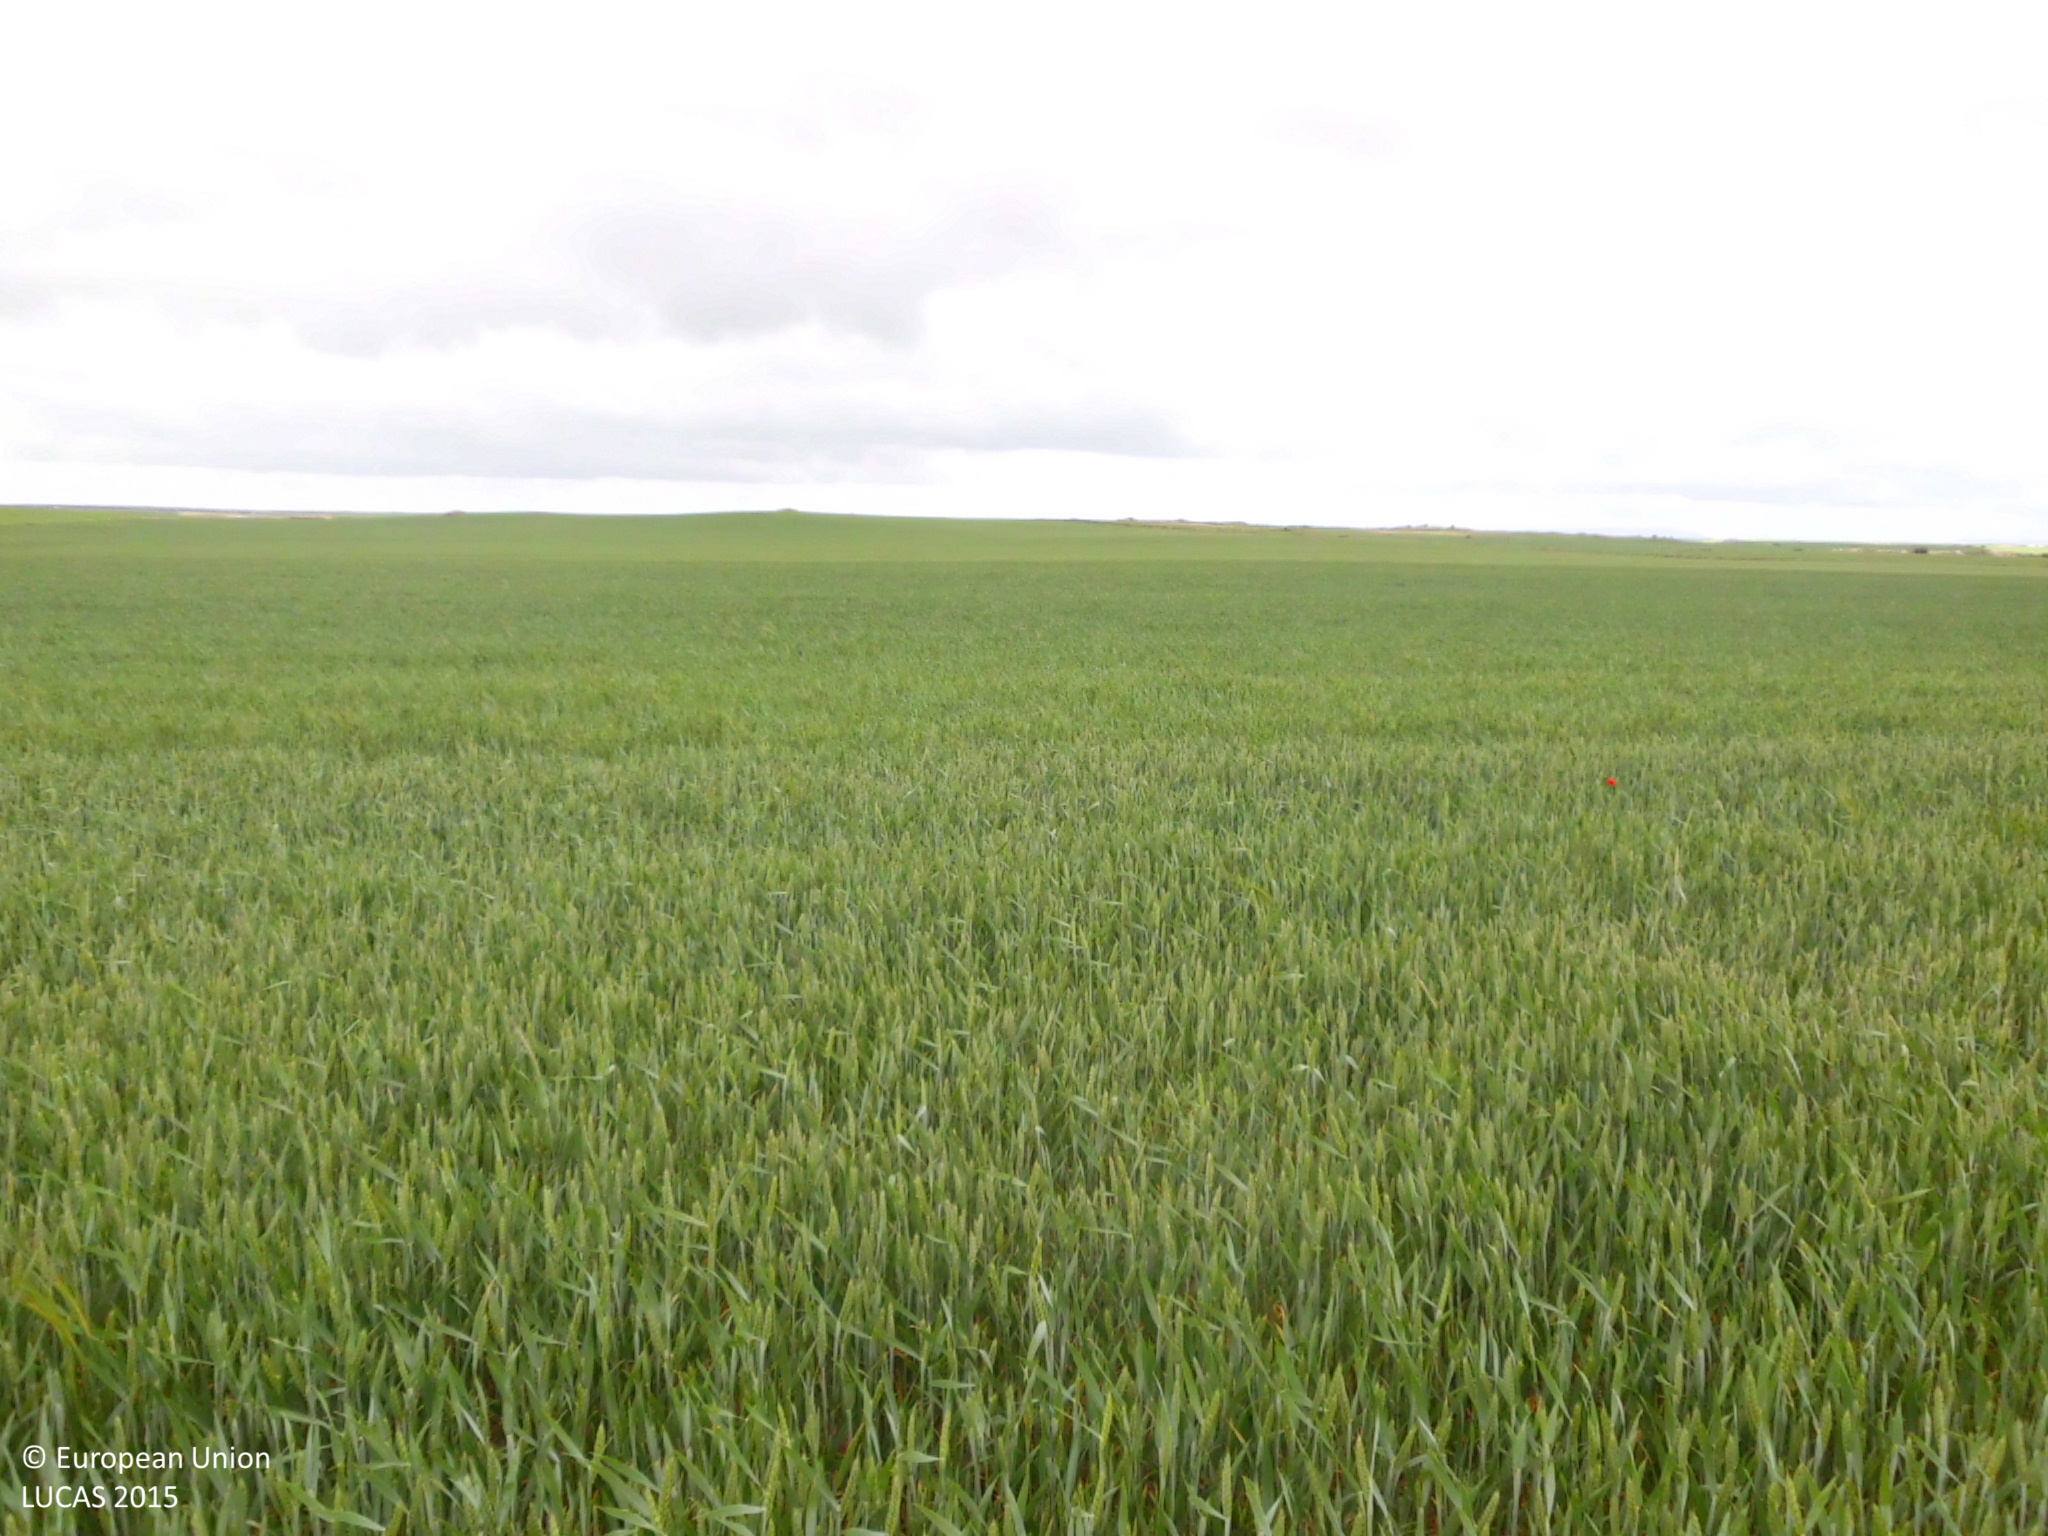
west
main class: Cropland
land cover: Common wheat
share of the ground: > 75 %
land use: Agriculture (excluding fallow land and kitchen gardens)
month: May
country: ES
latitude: 42.3891
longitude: -3.8750
